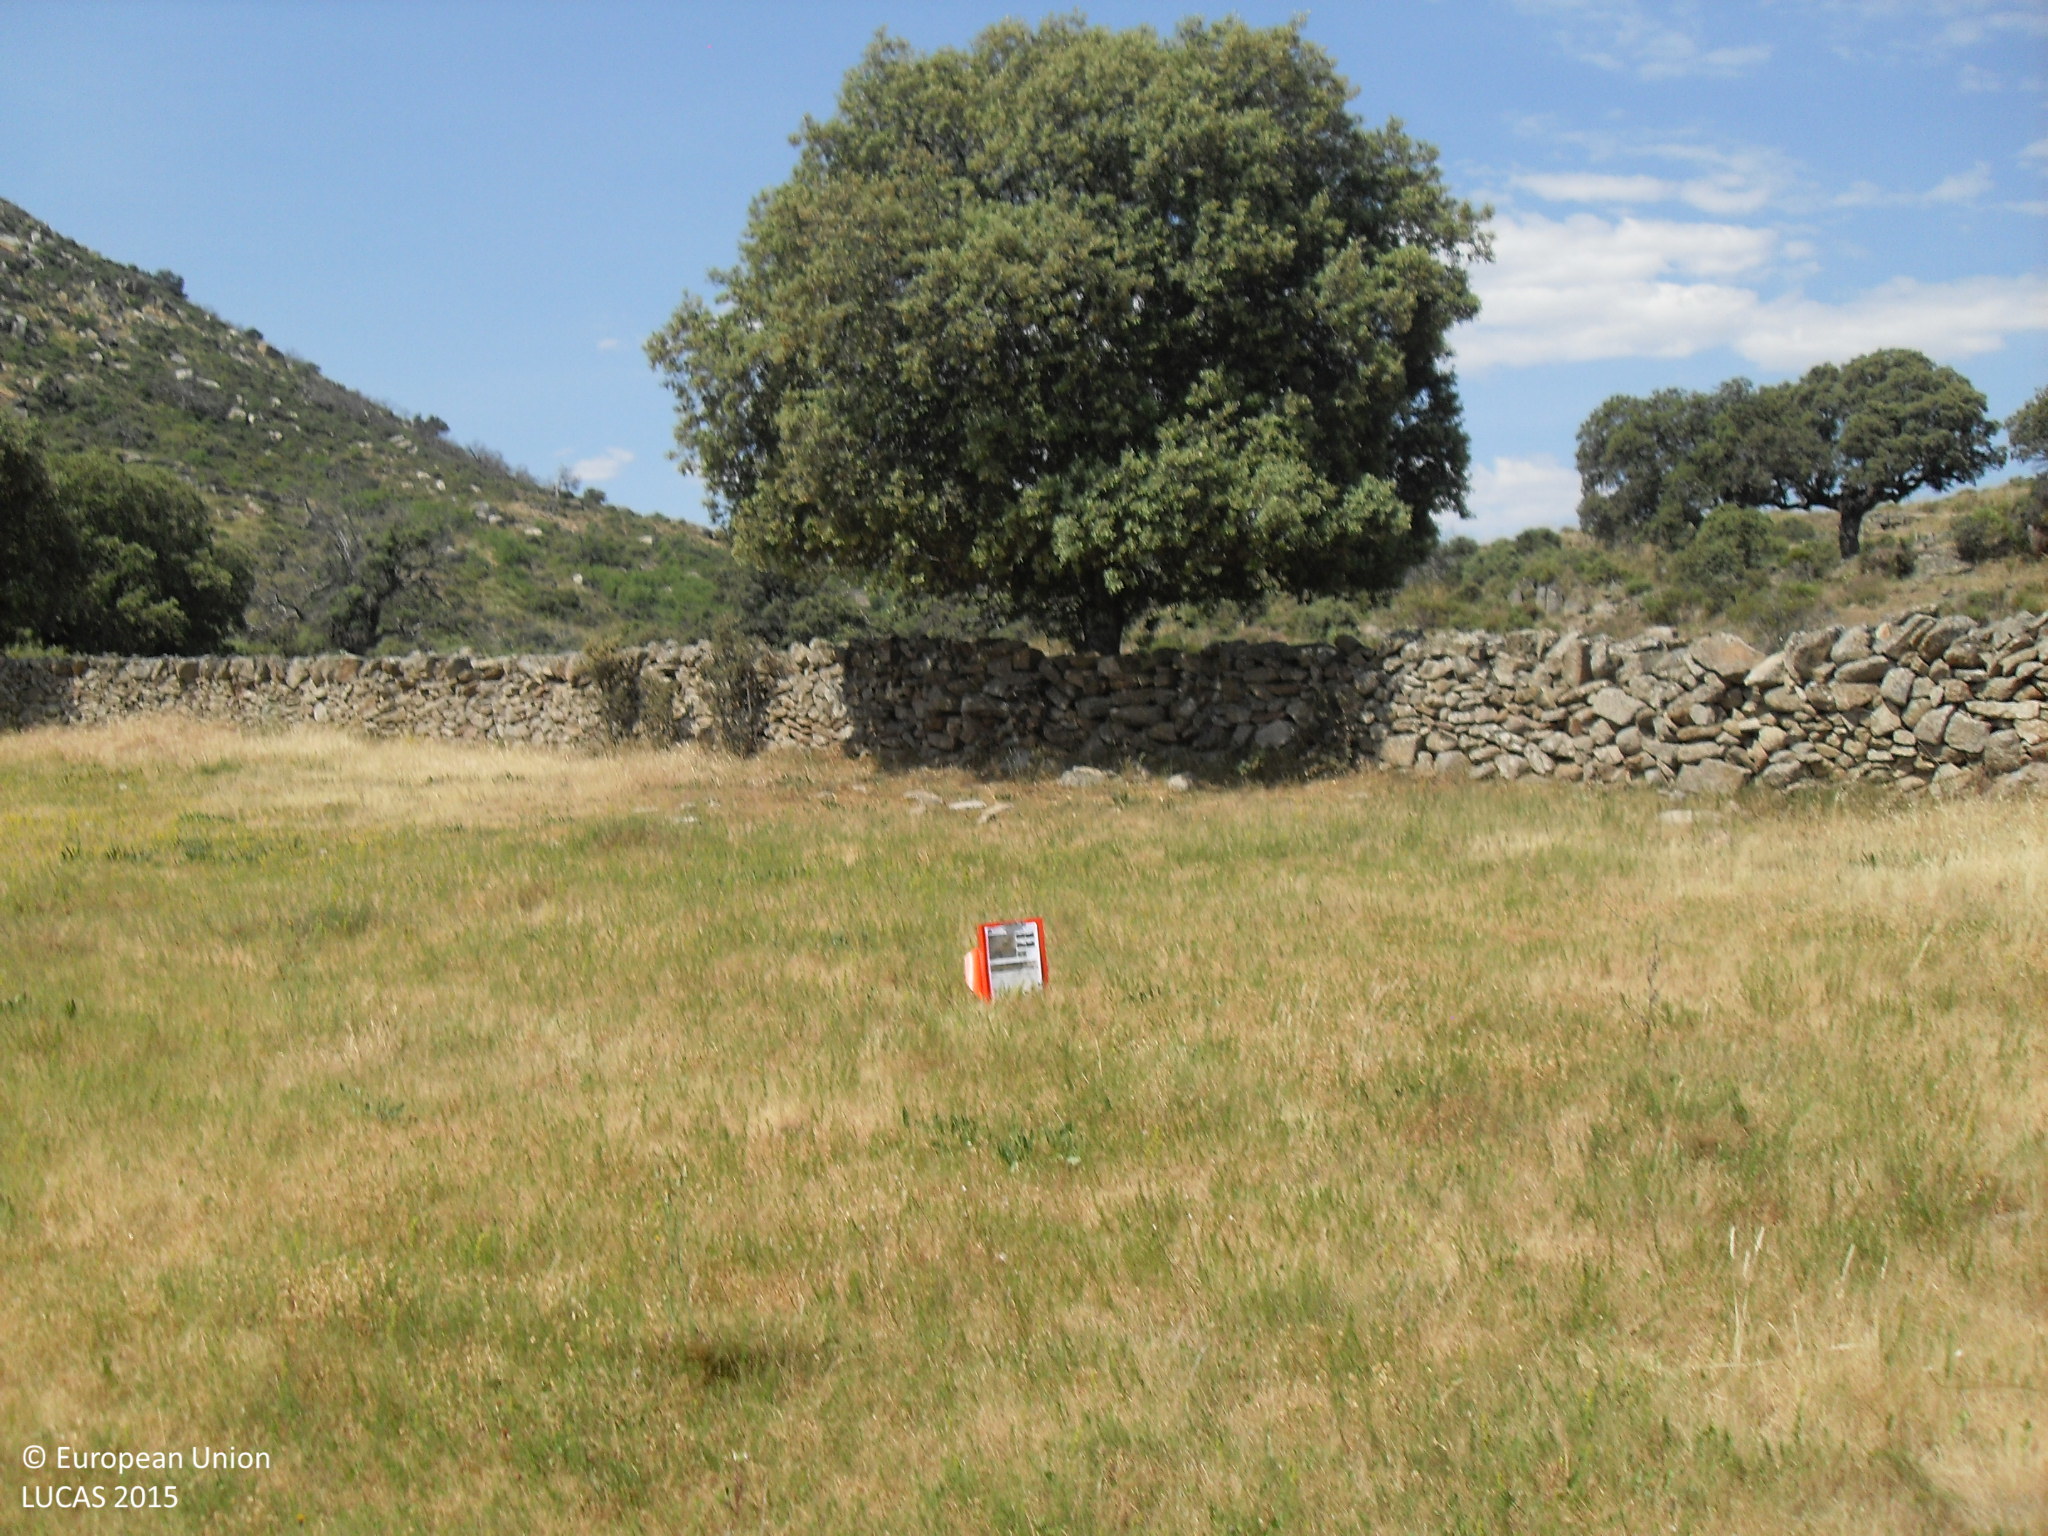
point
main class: Grassland
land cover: Grassland with sparse tree/shrub cover
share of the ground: > 75 %
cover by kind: herbaceous plants 95 %, broadleaved forest trees 5 %
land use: Agriculture (excluding fallow land and kitchen gardens)
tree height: < 5 m
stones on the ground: < 10 %
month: June
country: ES
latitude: 40.4704
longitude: -5.5542
